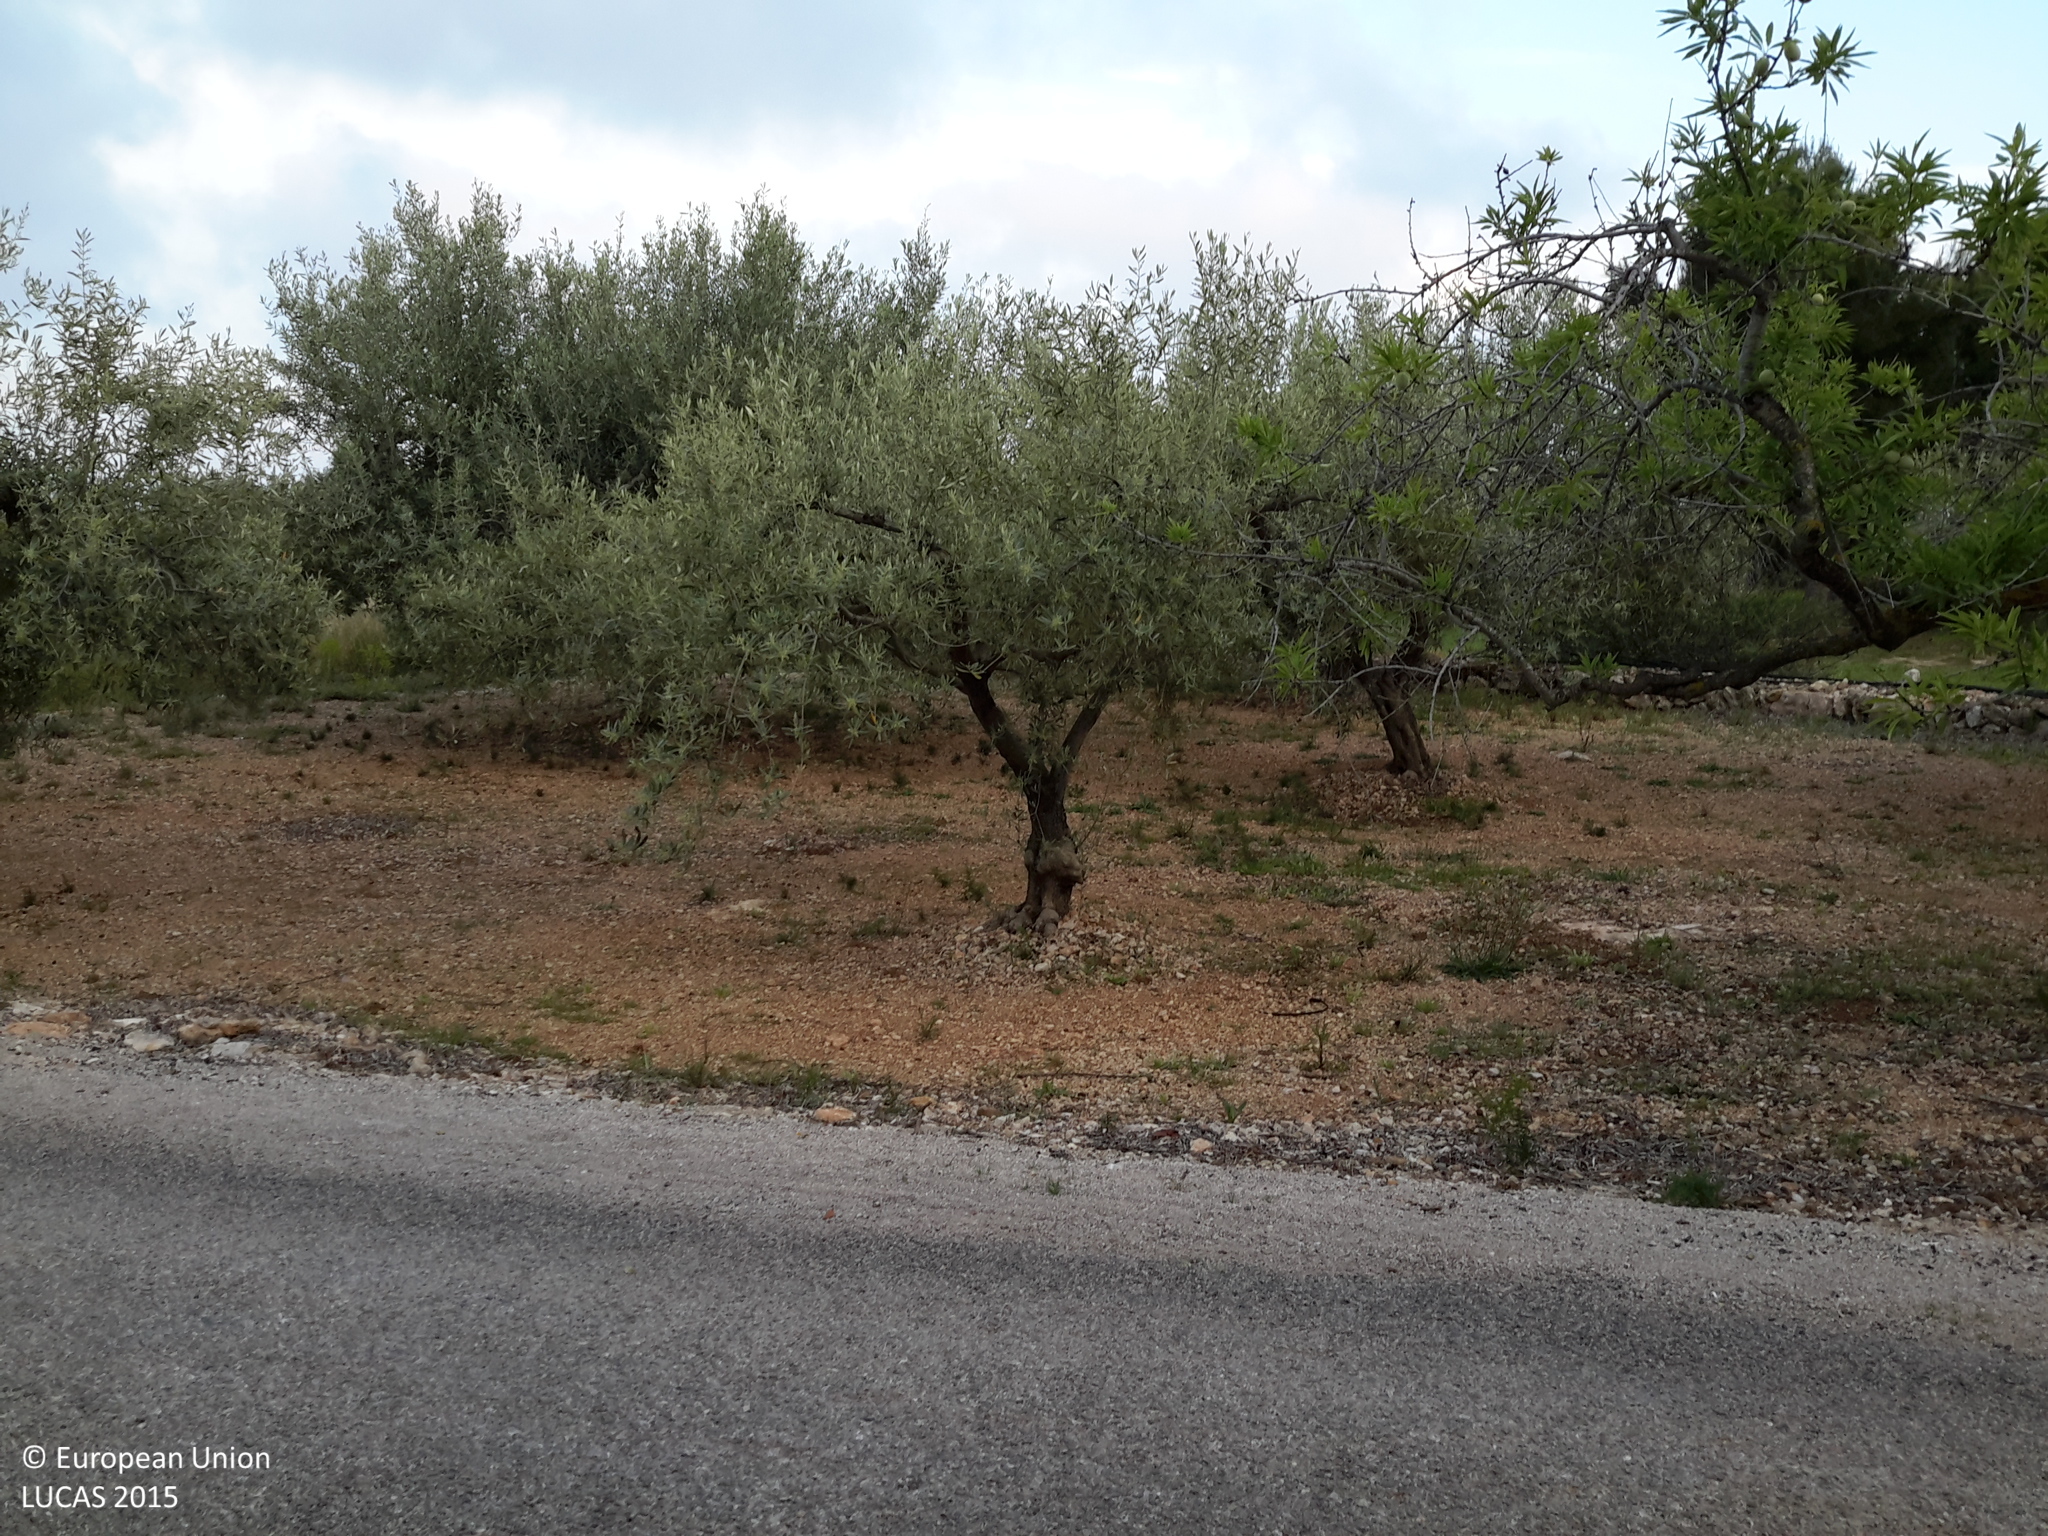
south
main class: Cropland
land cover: Olive groves
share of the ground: 25 - 50 %
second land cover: Spontaneously vegetated surfaces
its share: 25 - 50 %
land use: Agriculture (excluding fallow land and kitchen gardens)
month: April
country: ES
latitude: 40.6315
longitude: 0.5727
